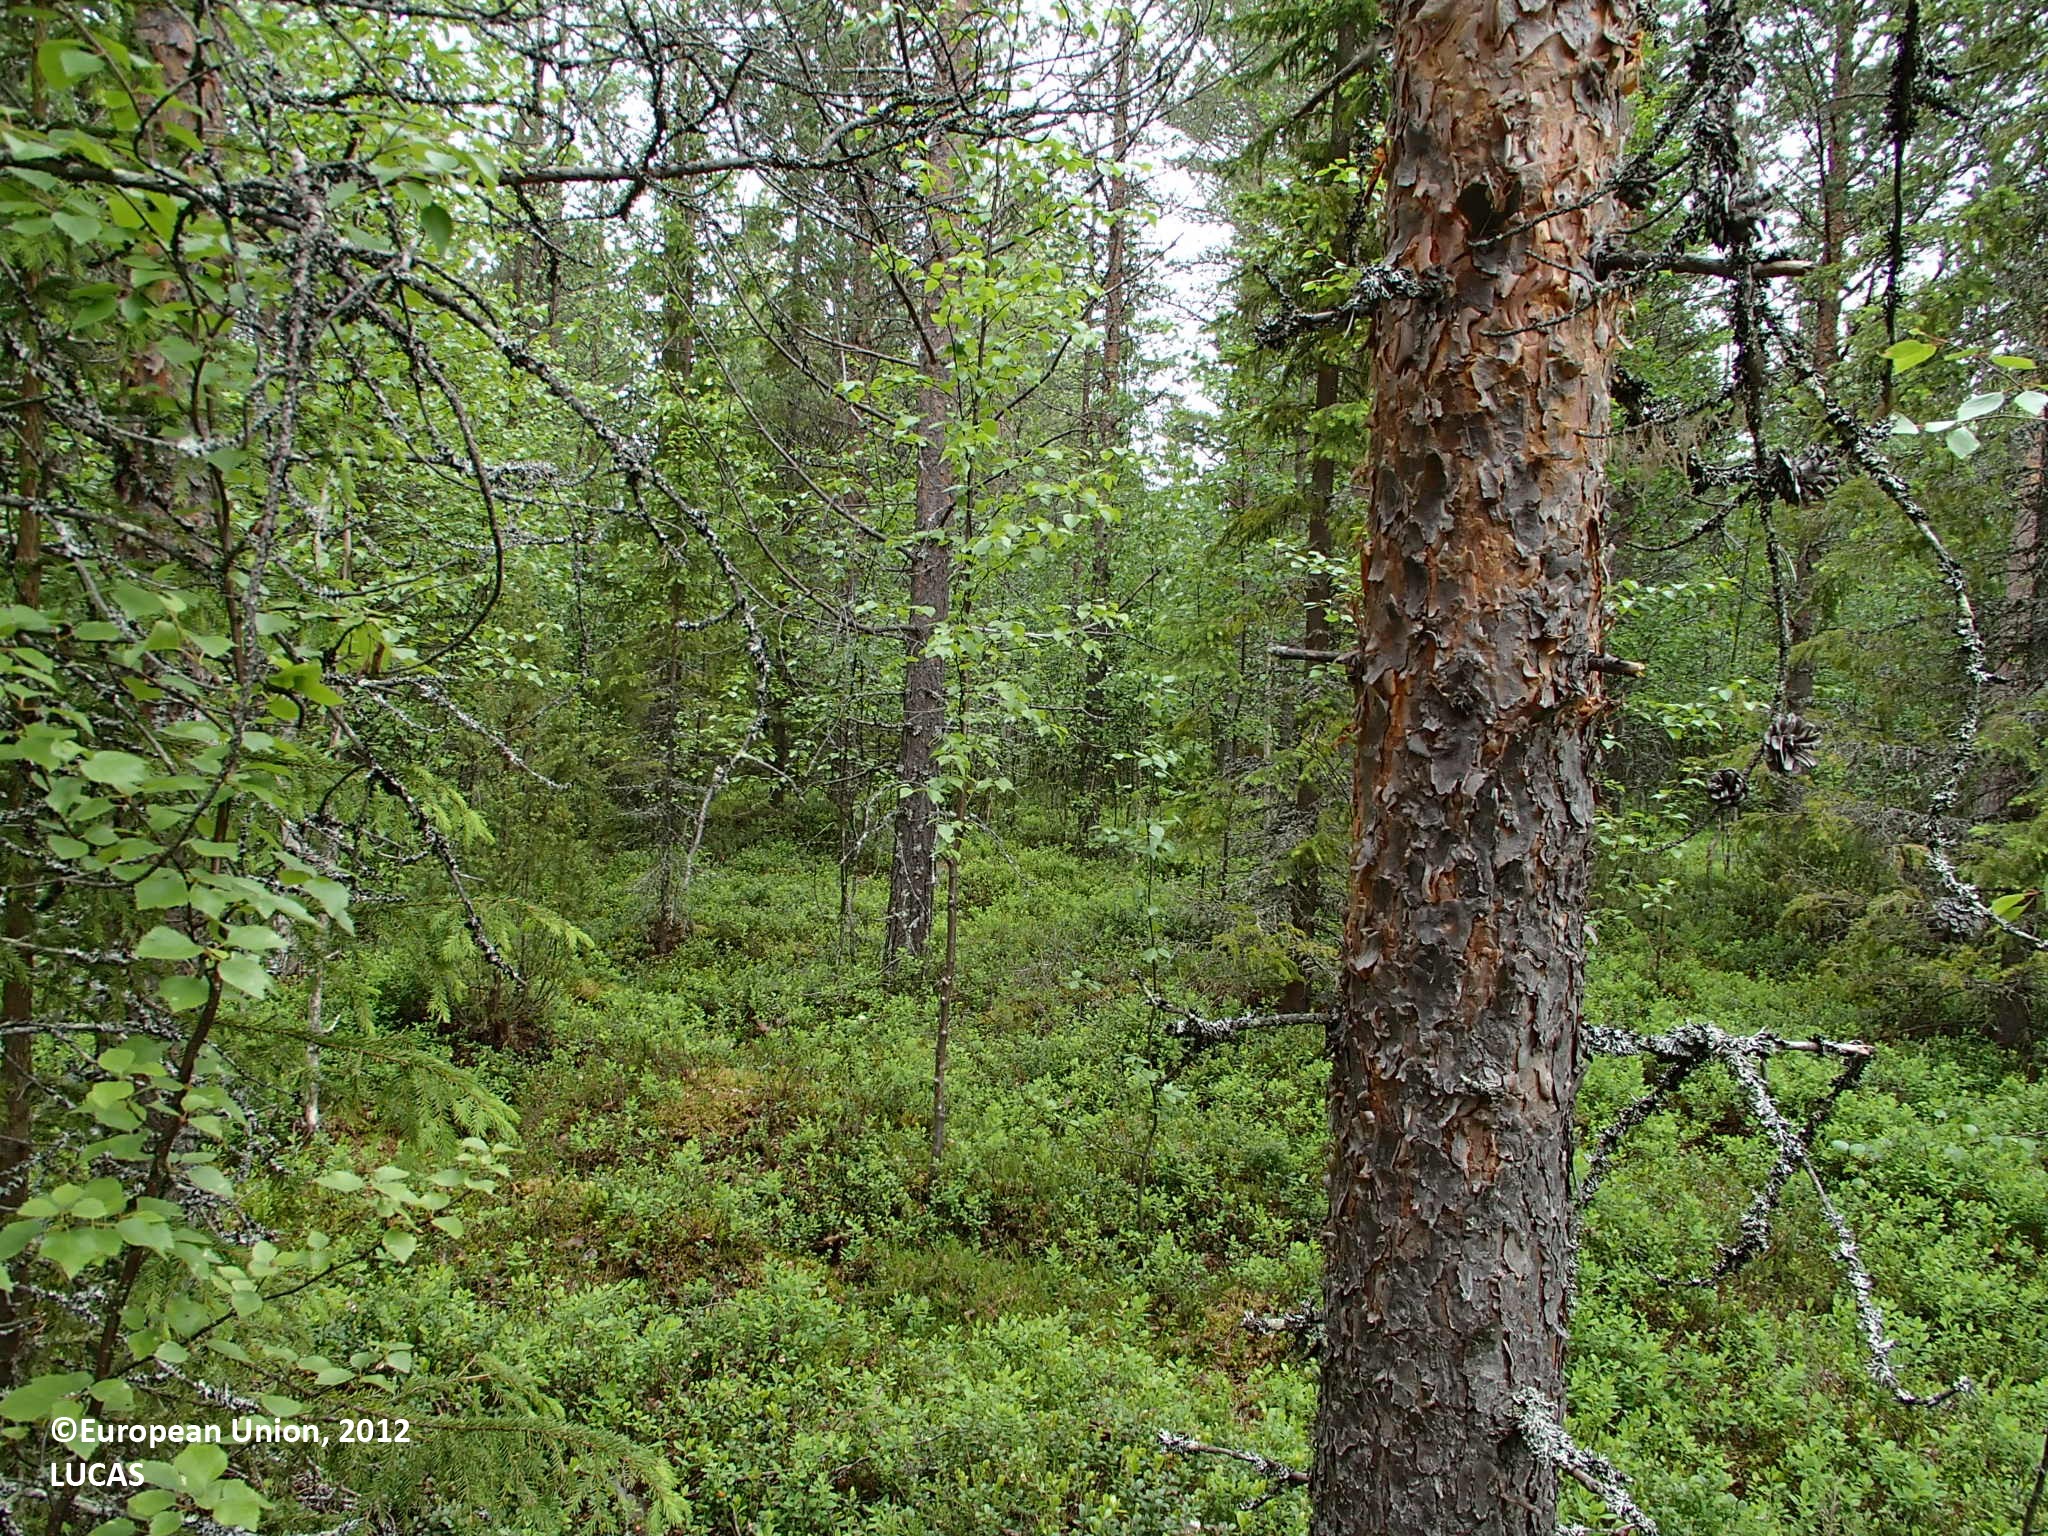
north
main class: Woodland
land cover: Pine dominated coniferous woodland
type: boreal forest
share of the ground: > 75 %
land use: Forestry
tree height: > 5 m
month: June
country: FI
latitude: 66.7870
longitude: 27.5027
